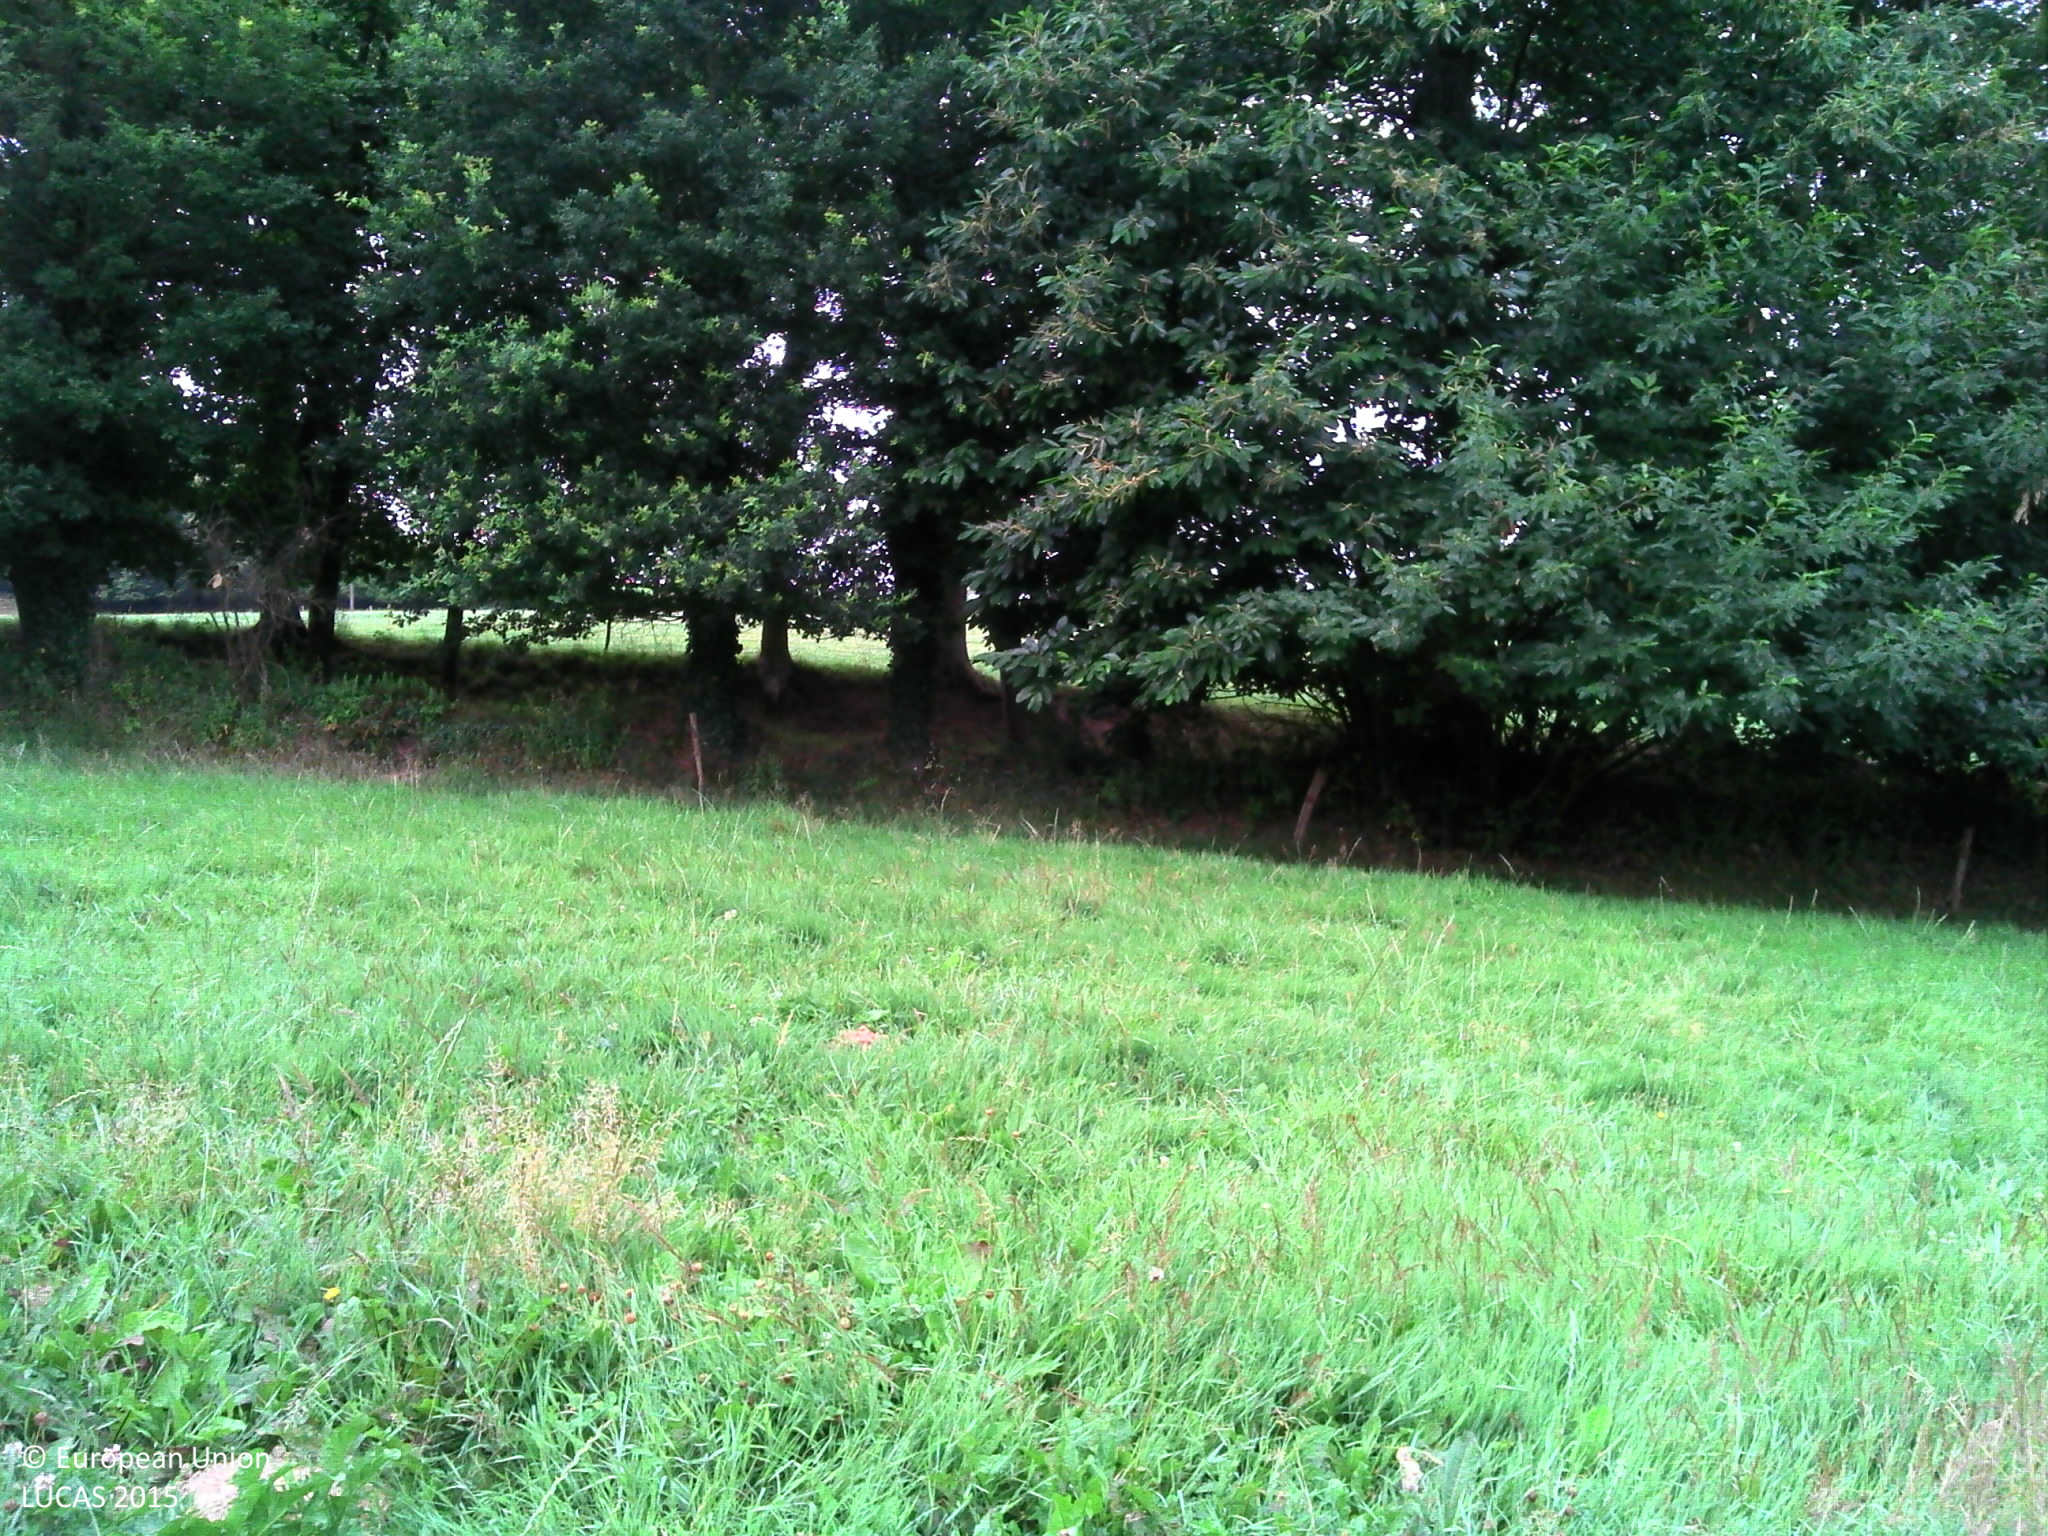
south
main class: Grassland
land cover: Grassland without tree/shrub cover
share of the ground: > 75 %
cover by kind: herbaceous plants 100 %
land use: Agriculture (excluding fallow land and kitchen gardens)
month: July
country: FR
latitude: 48.2555
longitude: -1.6723
